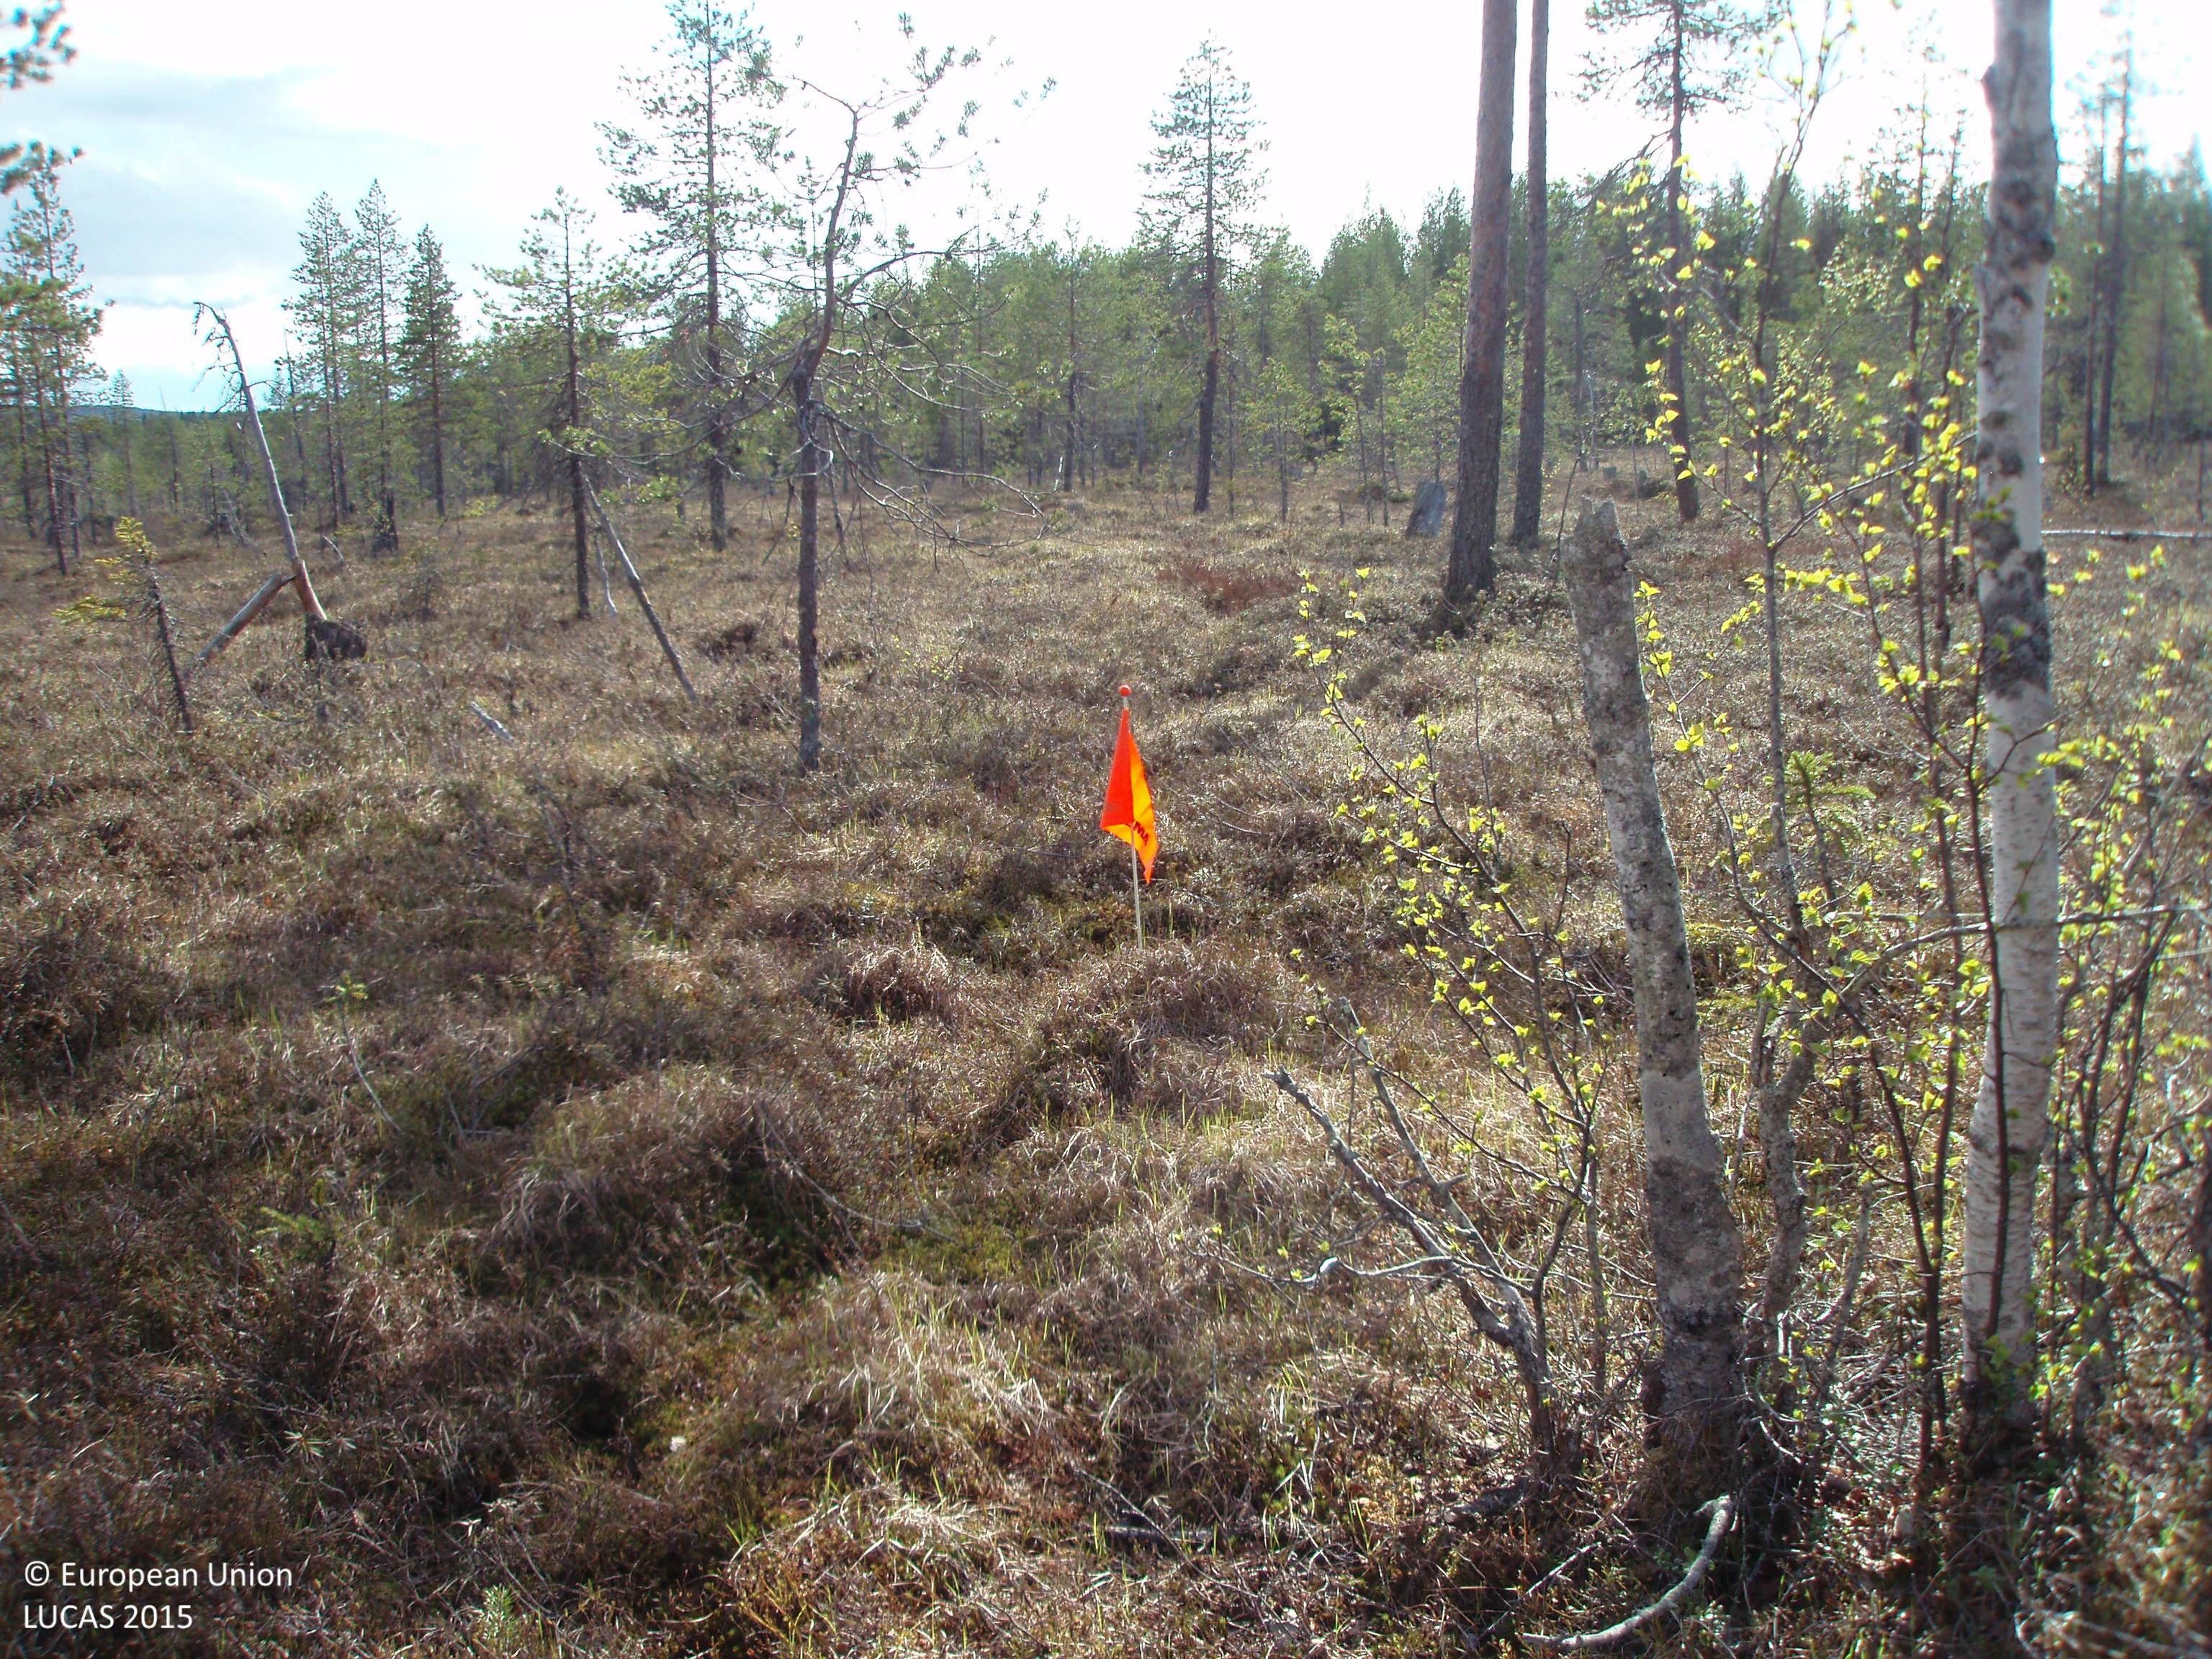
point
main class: Woodland
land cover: Pine dominated coniferous woodland
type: mire and swamp forests
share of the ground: 50 - 75 %
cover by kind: coniferous forest trees 50 %, shrubs 25 %, herbaceous plants 20 %, broadleaved forest trees 5 %
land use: Forestry
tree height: > 5 m
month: June
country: FI
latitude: 66.7227
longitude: 26.8507
